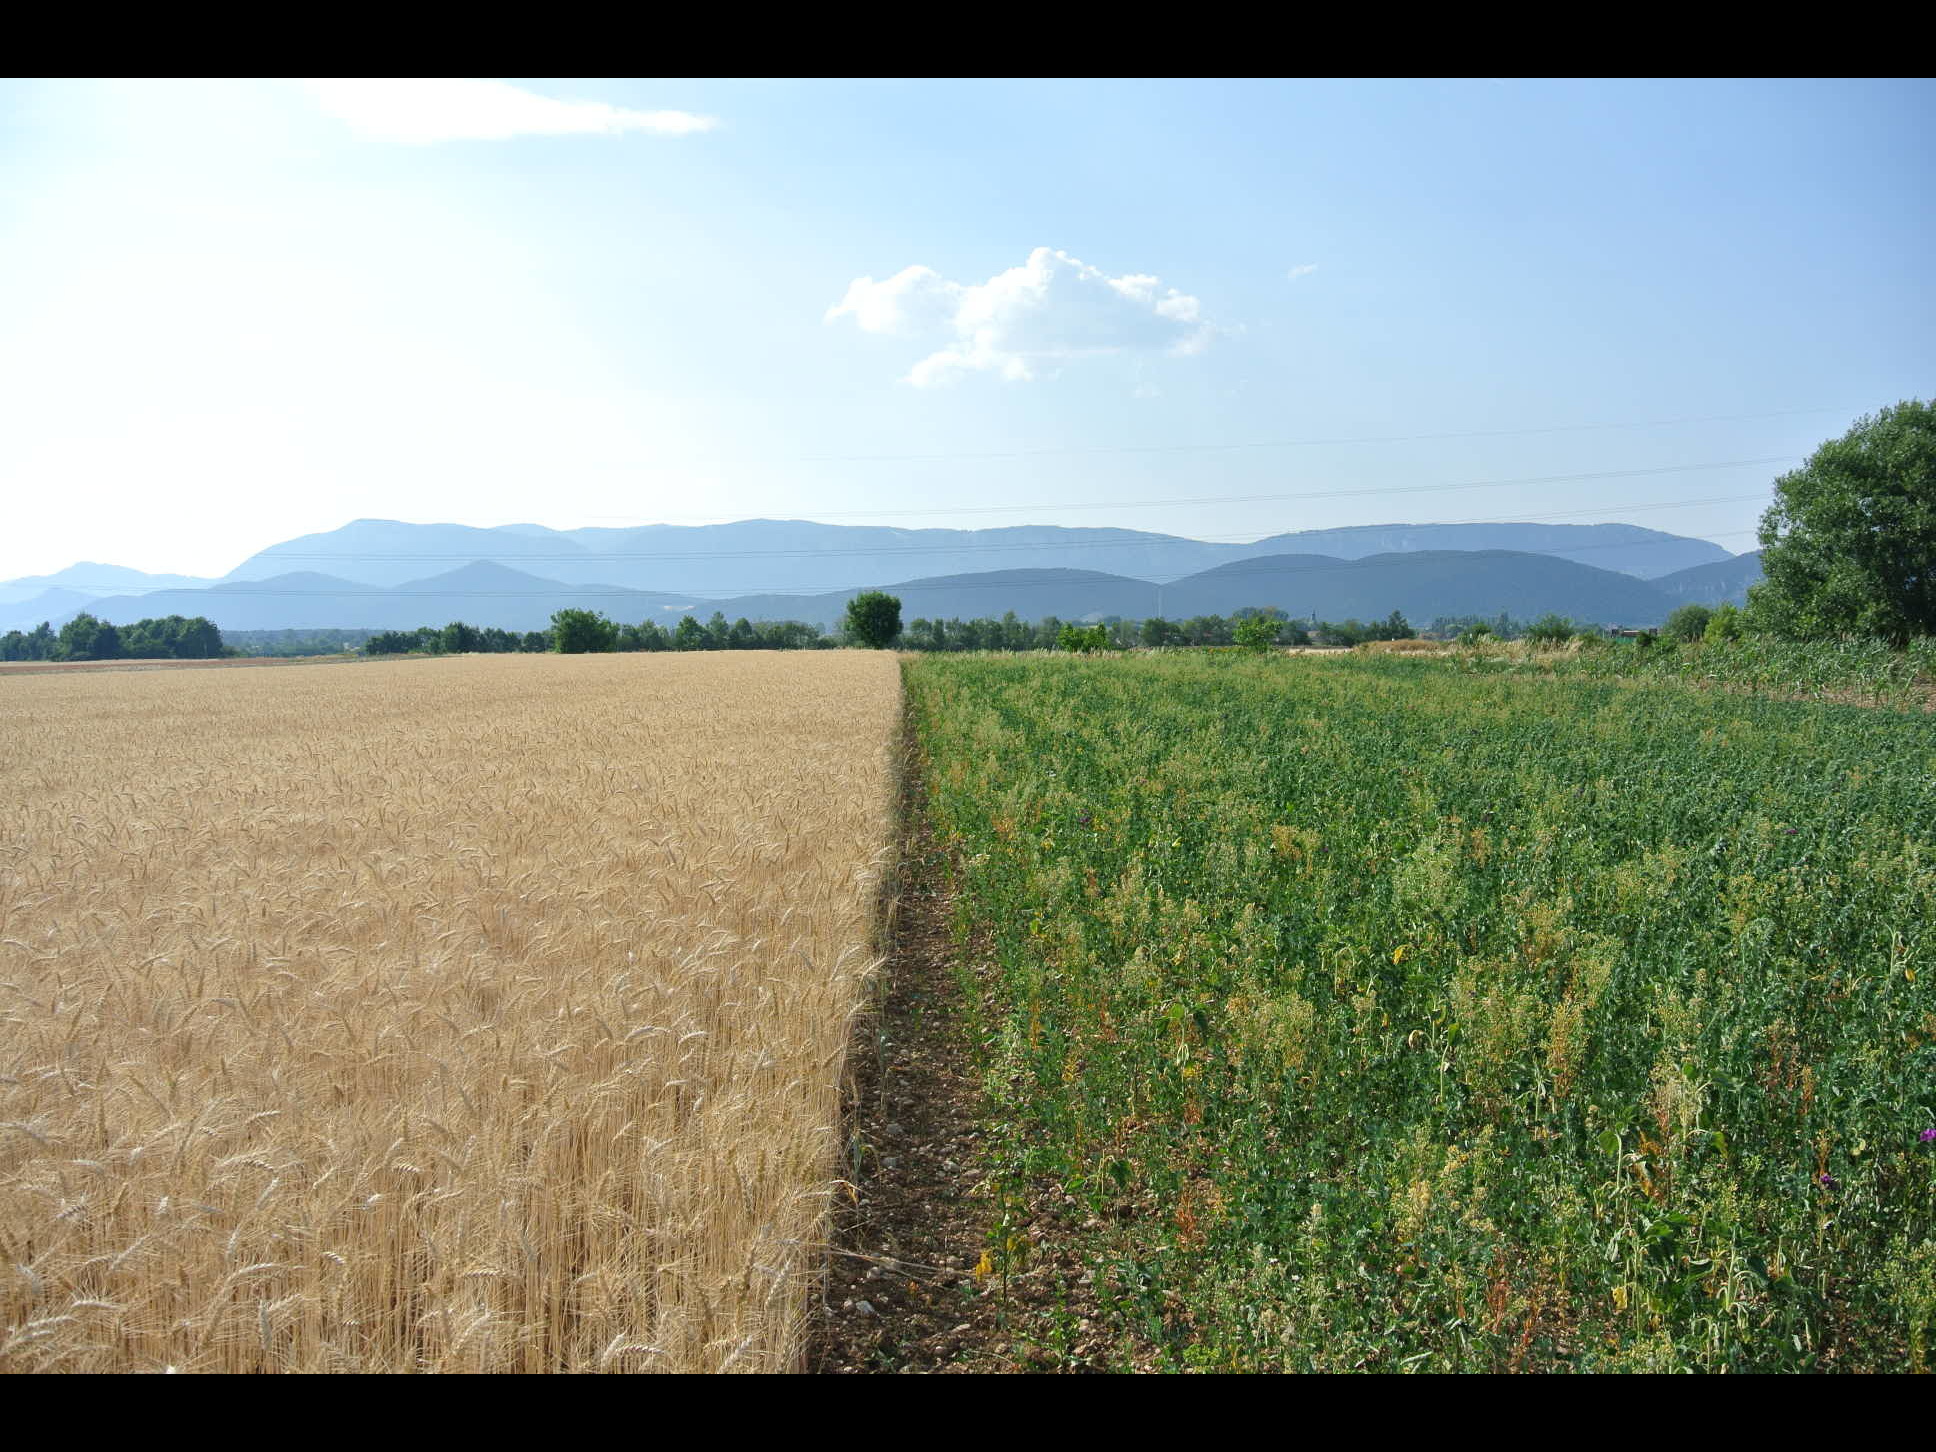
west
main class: Cropland
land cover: Common wheat
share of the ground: > 75 %
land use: Agriculture (excluding fallow land and kitchen gardens)
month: July
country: AT
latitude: 47.7823
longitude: 16.1294
